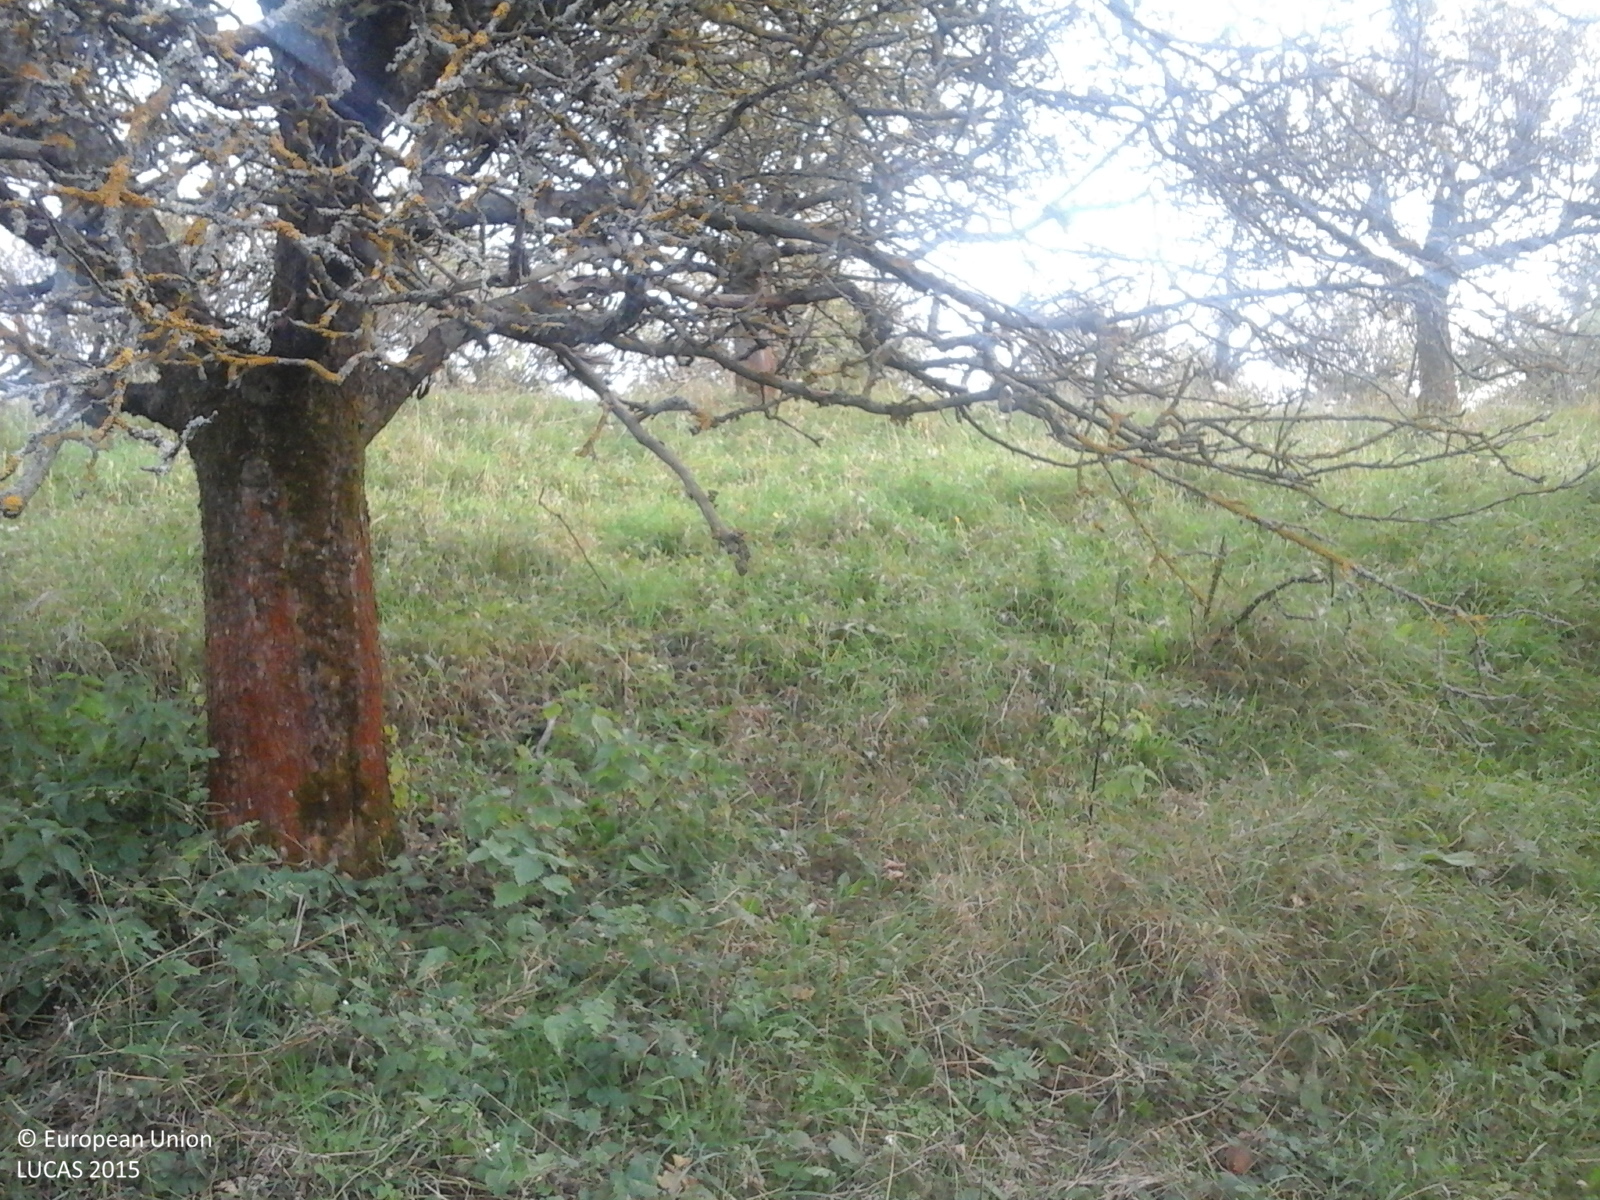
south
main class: Cropland
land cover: Apple fruit
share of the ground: > 75 %
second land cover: Grassland without tree/shrub cover
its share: > 75 %
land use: Agriculture (excluding fallow land and kitchen gardens)
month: September
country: RO
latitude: 46.7351
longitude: 23.6160
